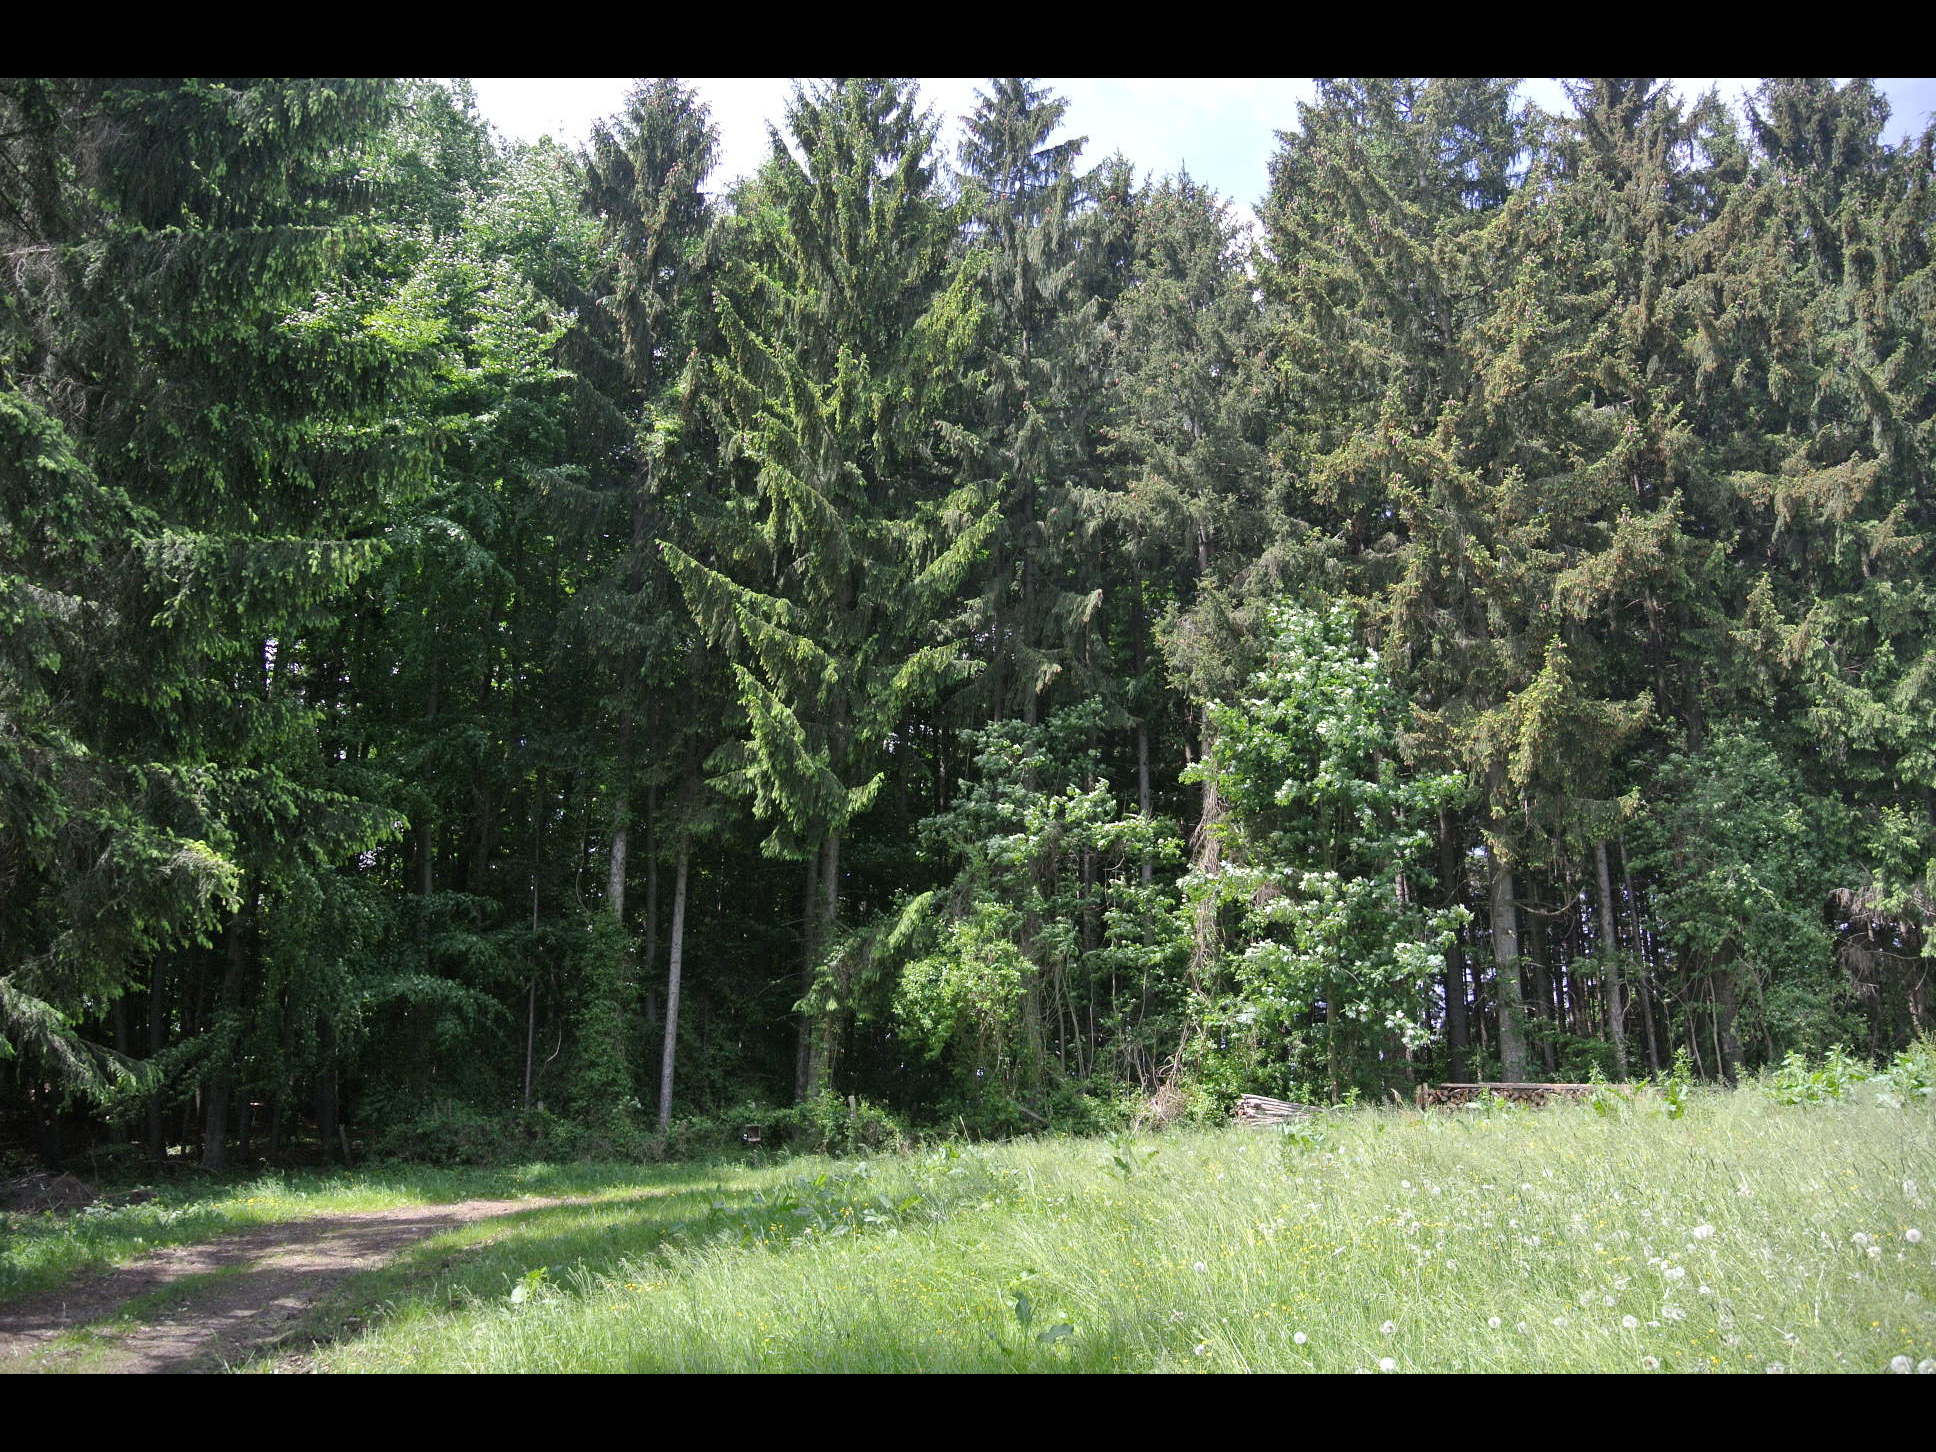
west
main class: Grassland
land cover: Grassland without tree/shrub cover
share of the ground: > 75 %
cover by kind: herbaceous plants 100 %
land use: Agriculture (excluding fallow land and kitchen gardens)
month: May
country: AT
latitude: 48.0163
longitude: 15.8079
